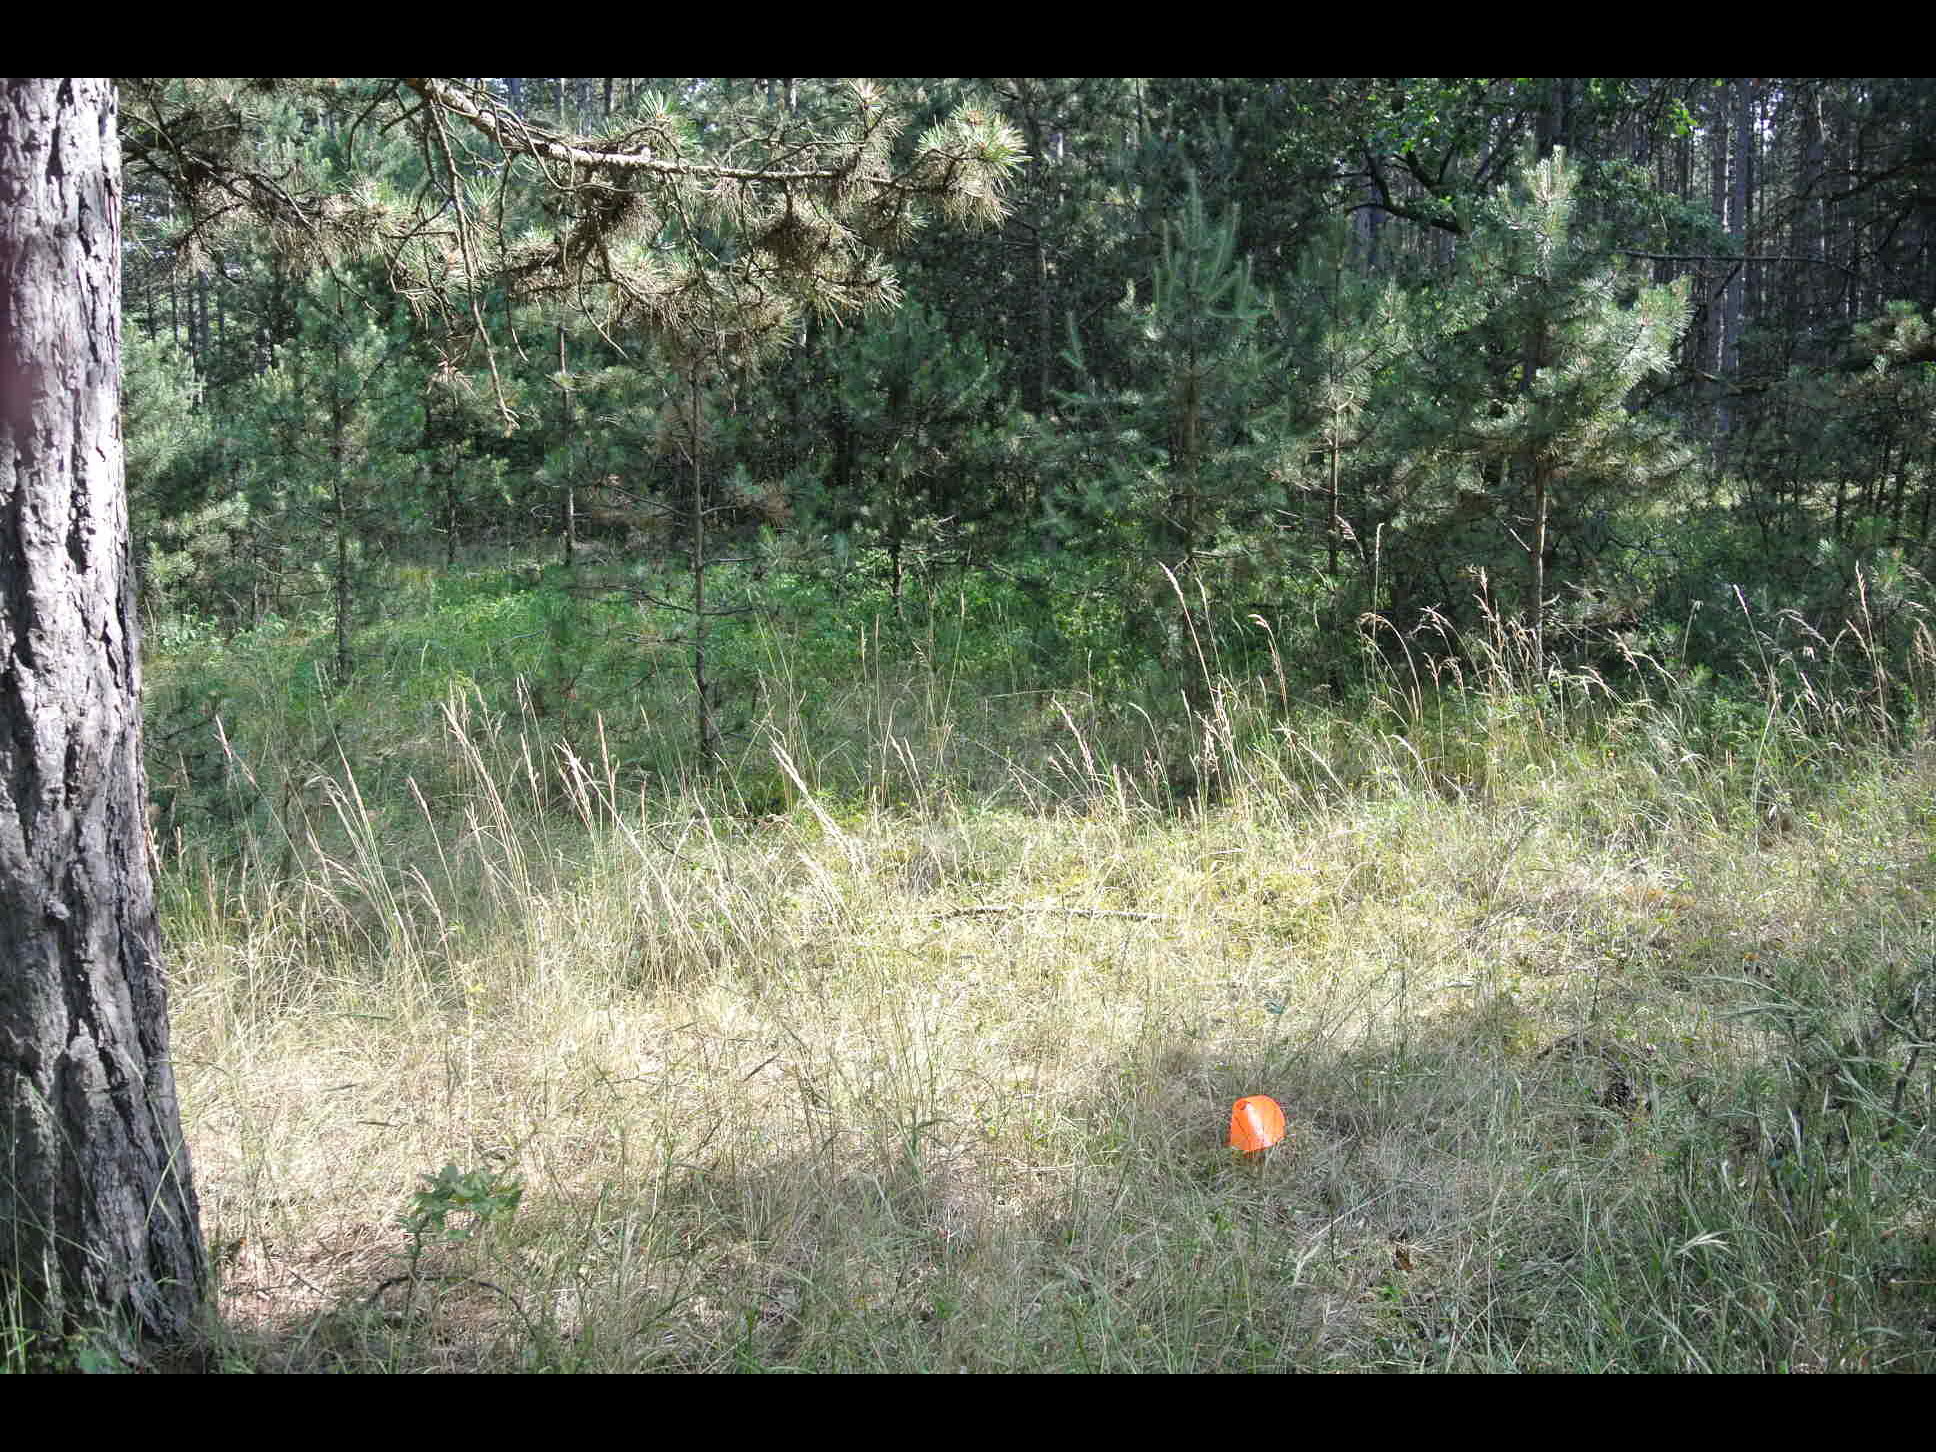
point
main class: Woodland
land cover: Pine dominated coniferous woodland
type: alpine coniferous forest
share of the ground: 25 - 50 %
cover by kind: coniferous forest trees 90 %, herbaceous plants 10 %
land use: Forestry
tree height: > 5 m
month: July
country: AT
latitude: 47.7629
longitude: 16.1538
